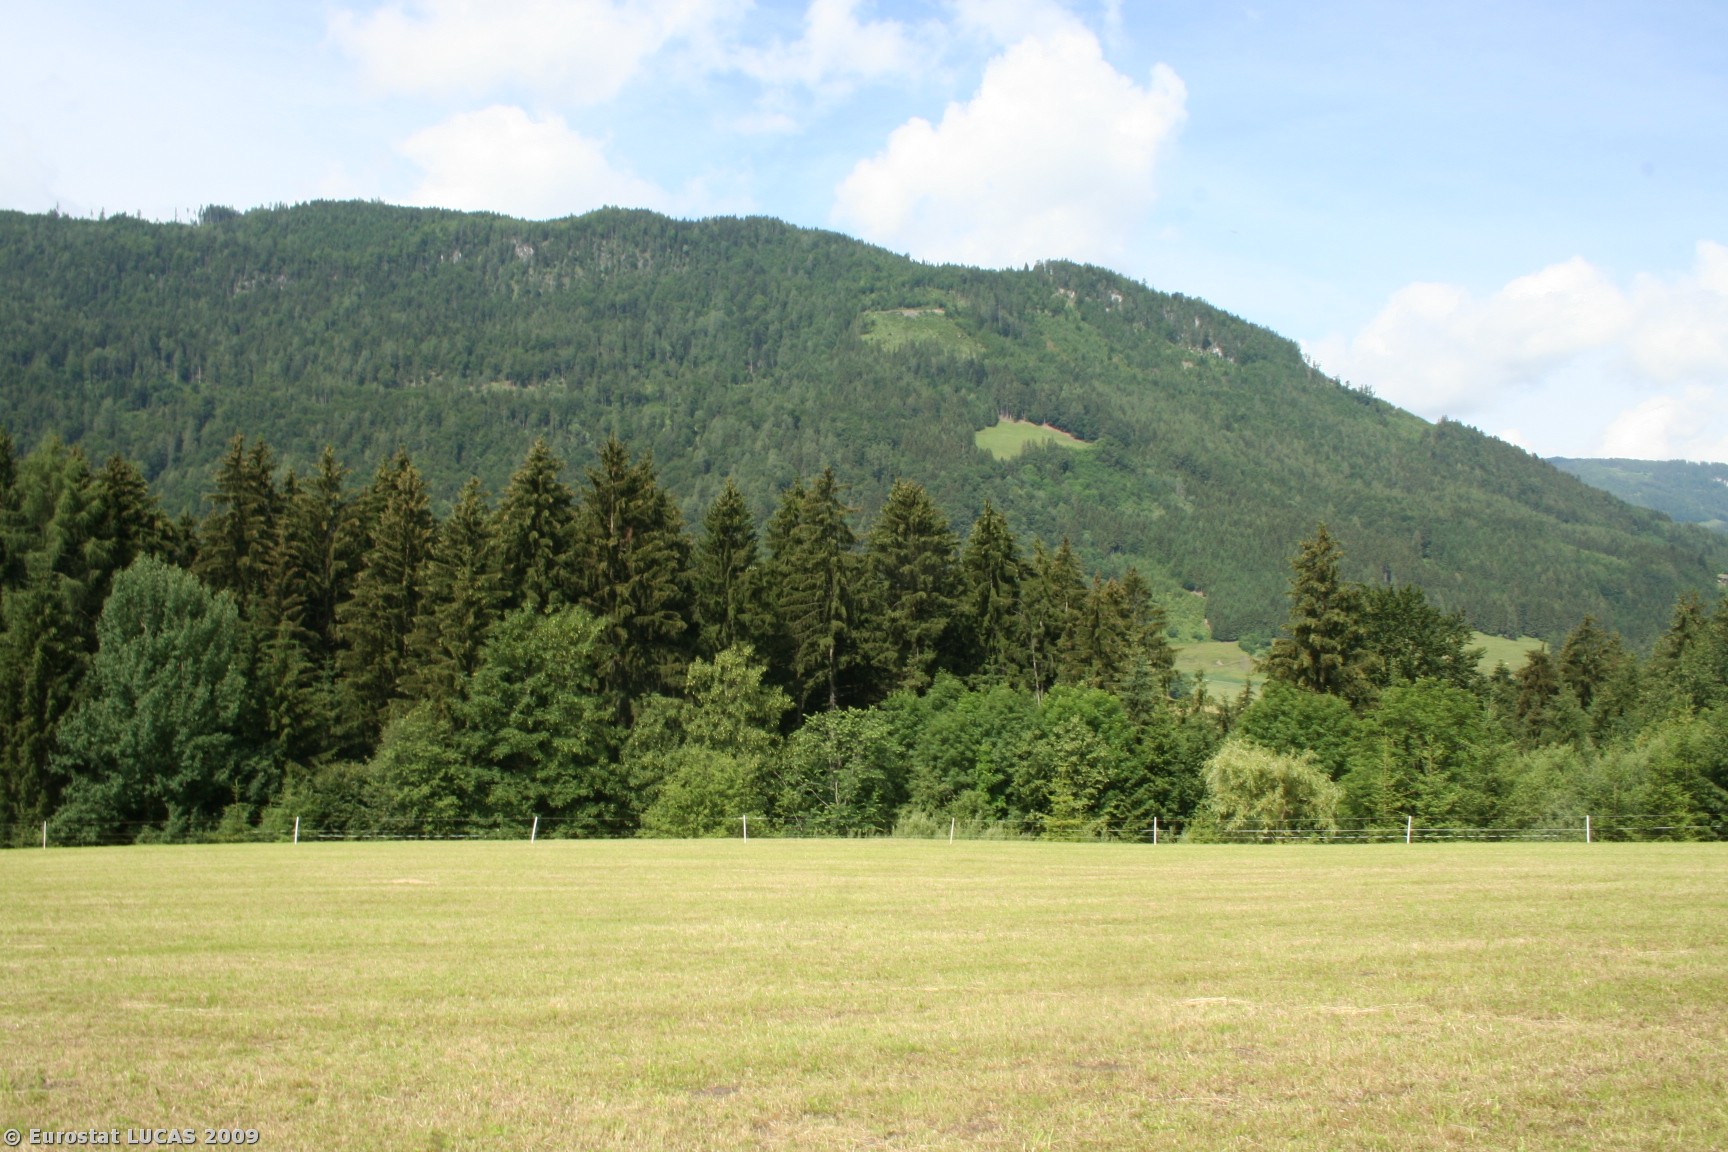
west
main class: Grassland
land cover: Grassland without tree/shrub cover
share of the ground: > 75 %
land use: Agriculture (excluding fallow land and kitchen gardens)
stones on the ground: < 10 %
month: June
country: AT
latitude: 47.4380
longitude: 13.2203
